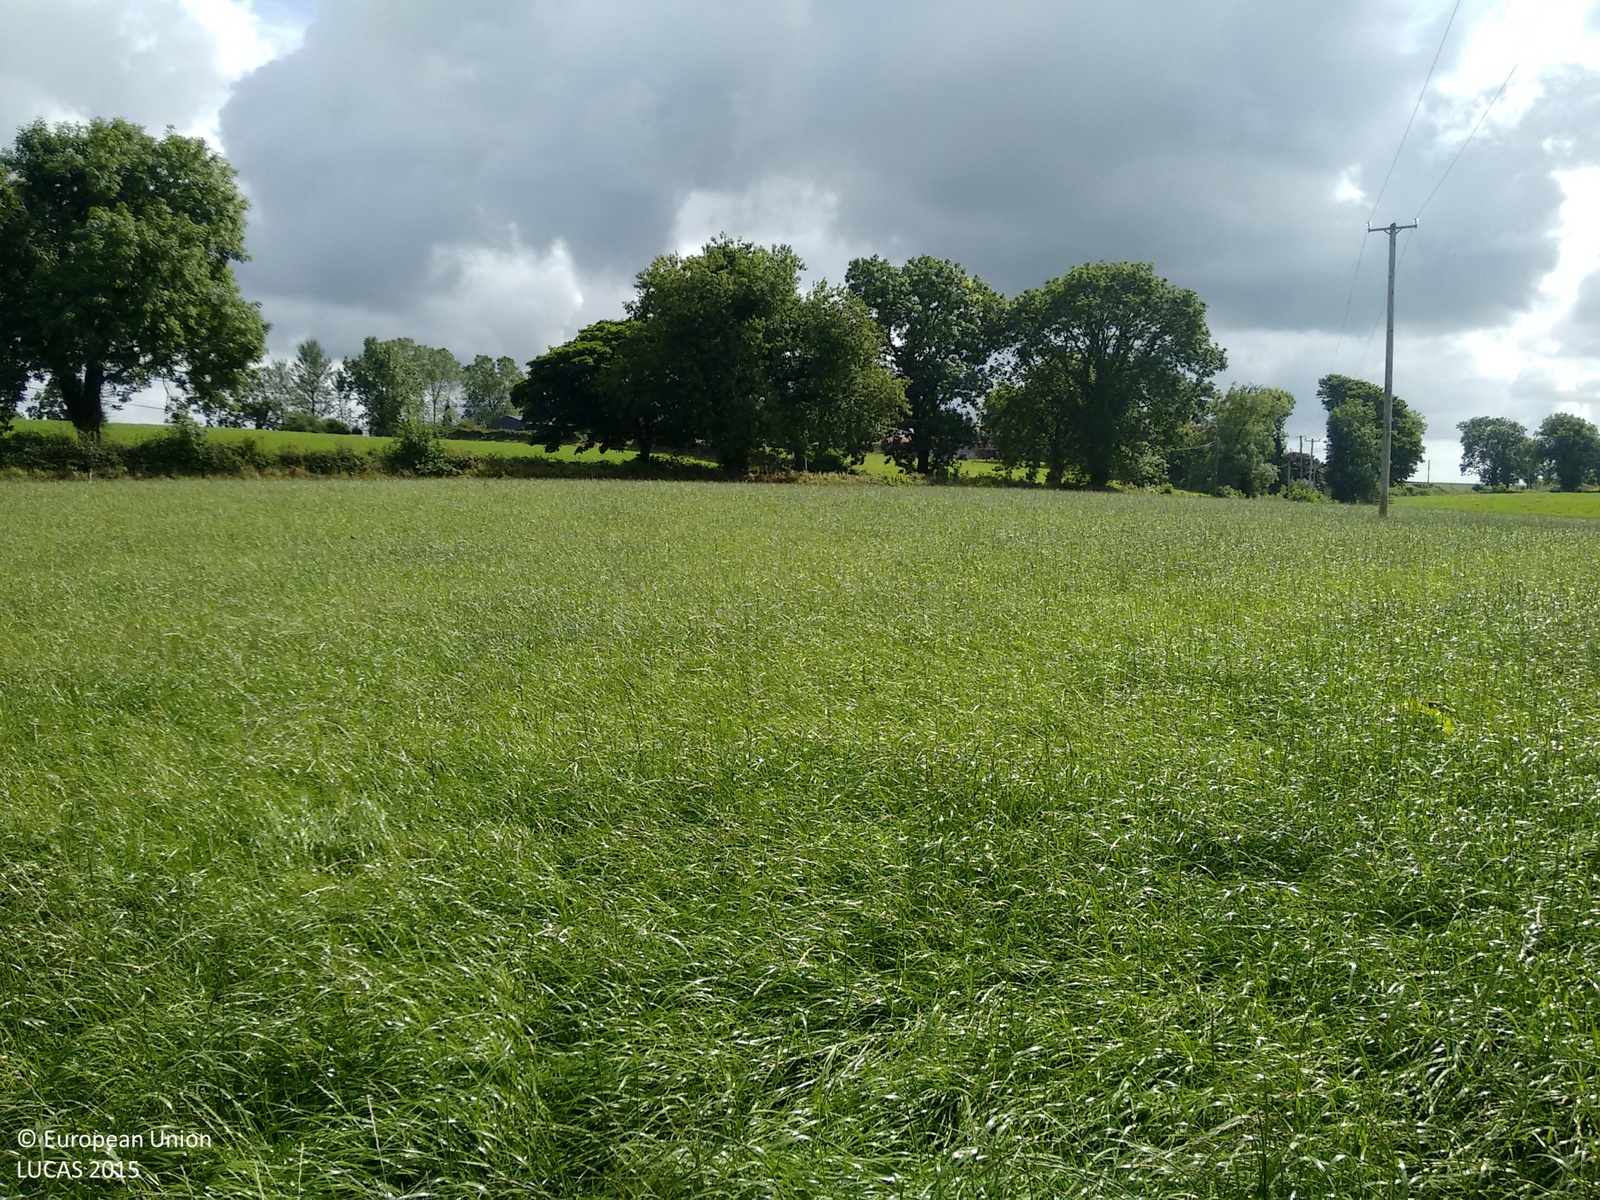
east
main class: Cropland
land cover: Temporary grasslands
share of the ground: > 75 %
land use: Agriculture (excluding fallow land and kitchen gardens)
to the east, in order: Temporary grasslands; Fences; Managed hedges; Electric lines; Paved roads, cycling and walking lanes; Managed hedges; Grassland without tree/shrub cover; Managed hedges; Fences; Grassland without tree/shrub cover; Artificial constructions in urban areas
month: August
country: IE
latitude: 54.0400
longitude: -6.5109
